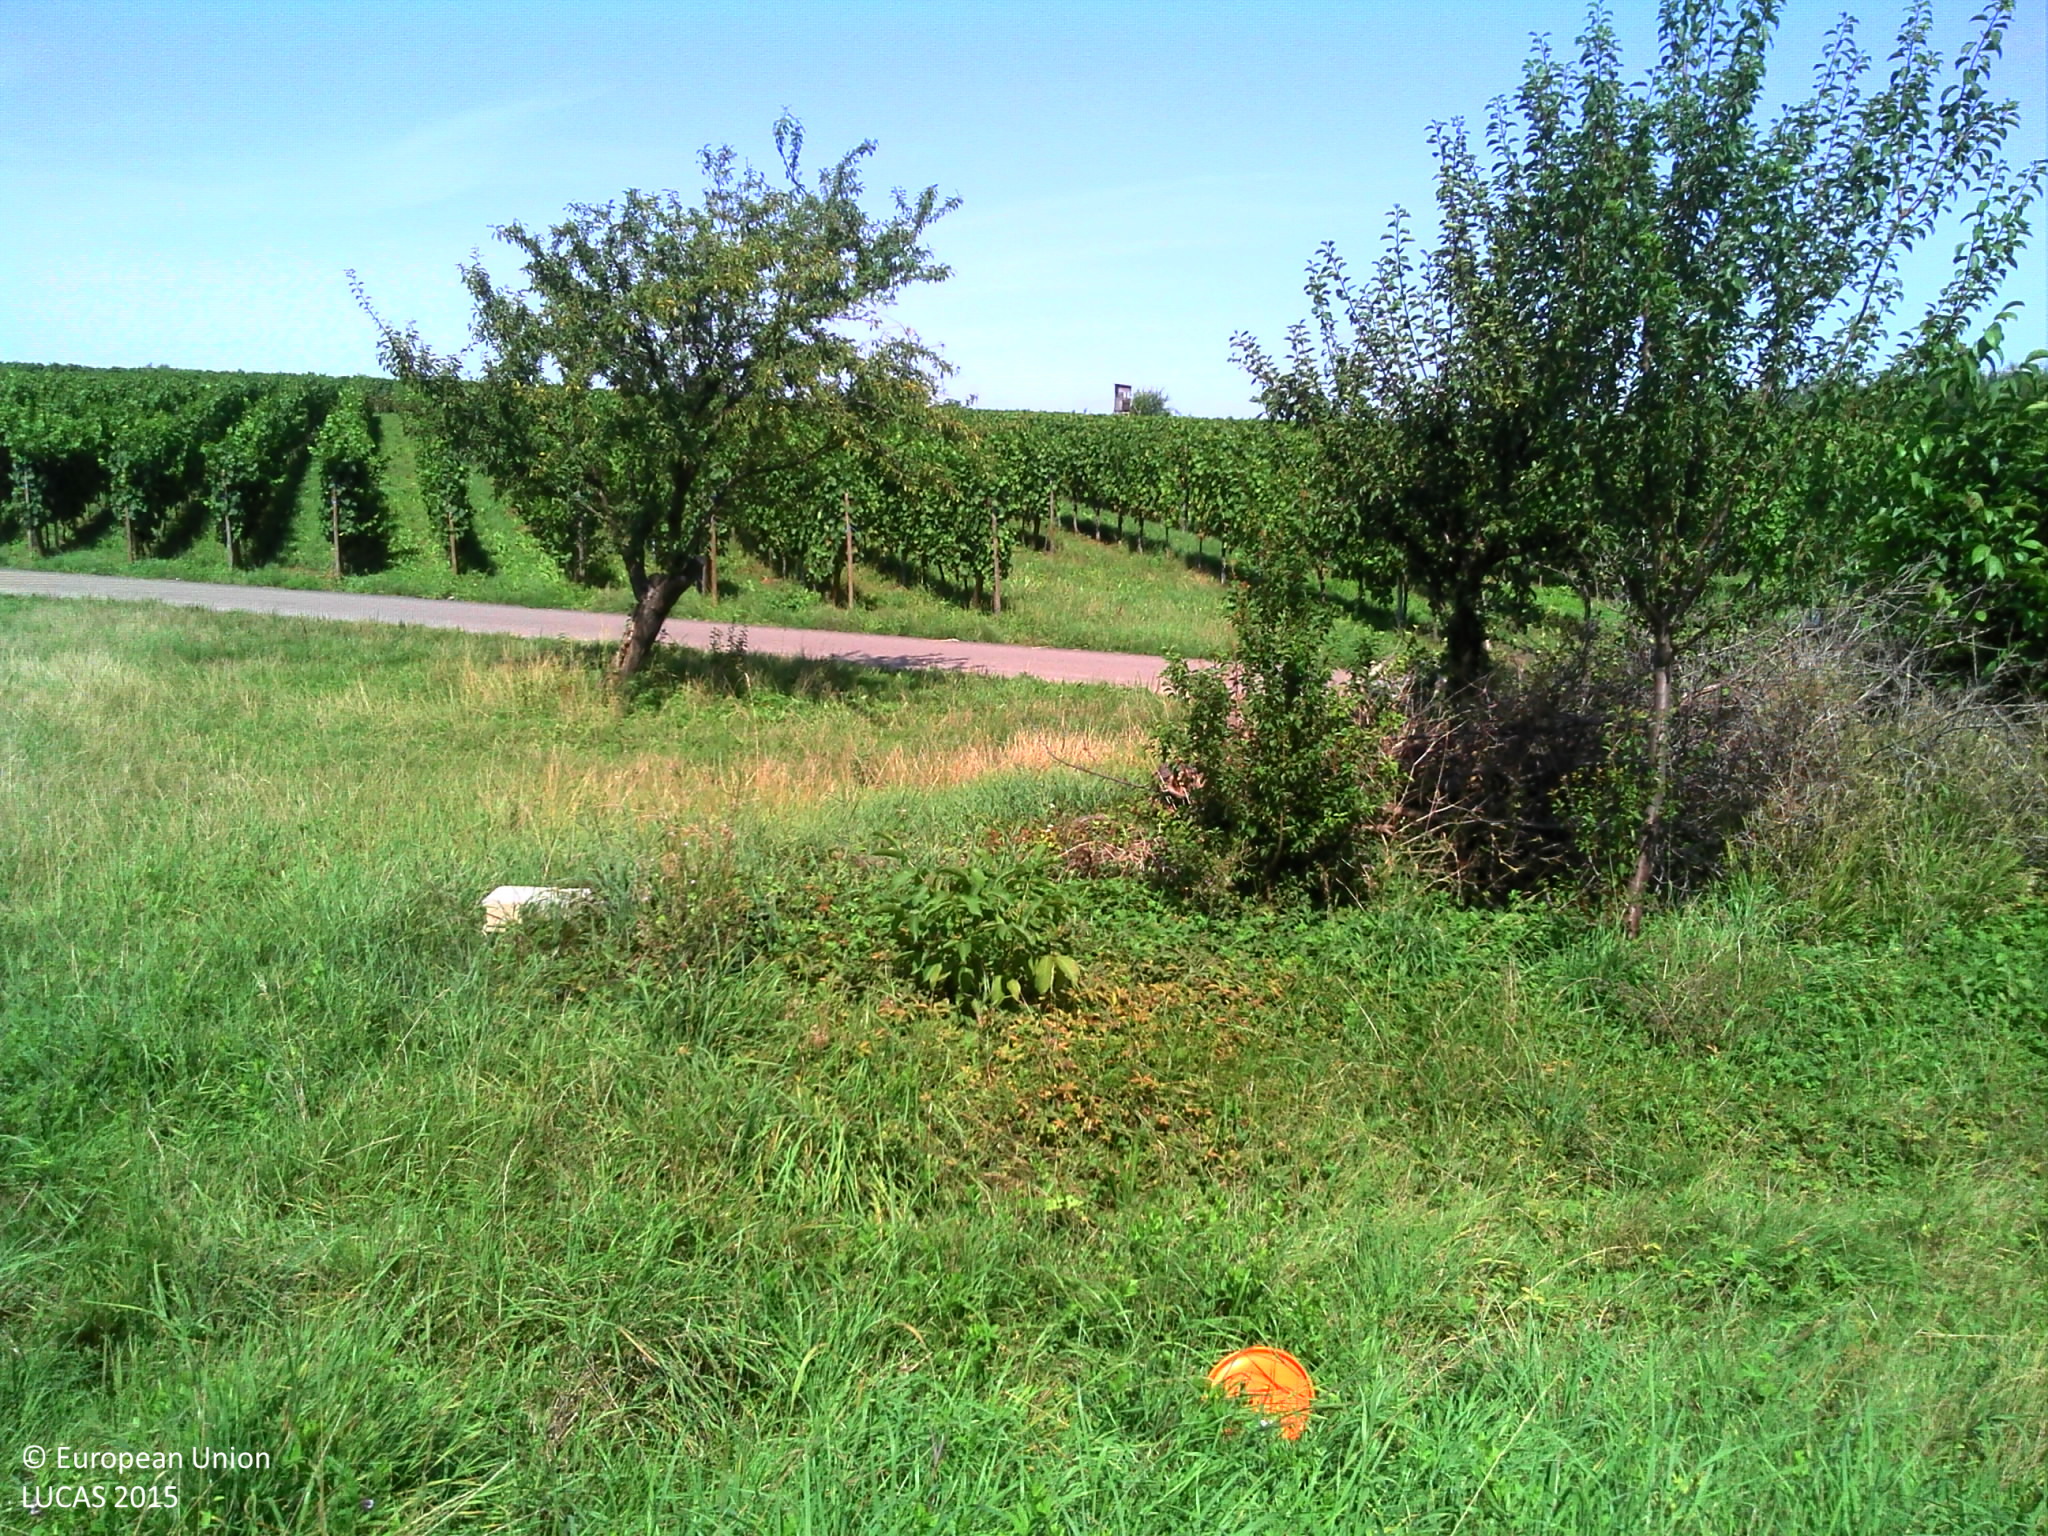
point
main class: Grassland
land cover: Grassland with sparse tree/shrub cover
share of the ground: > 75 %
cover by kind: herbaceous plants 95 %, broadleaved forest trees 5 %
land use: Agriculture (excluding fallow land and kitchen gardens)
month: August
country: FR
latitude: 48.3567
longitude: 7.4772
